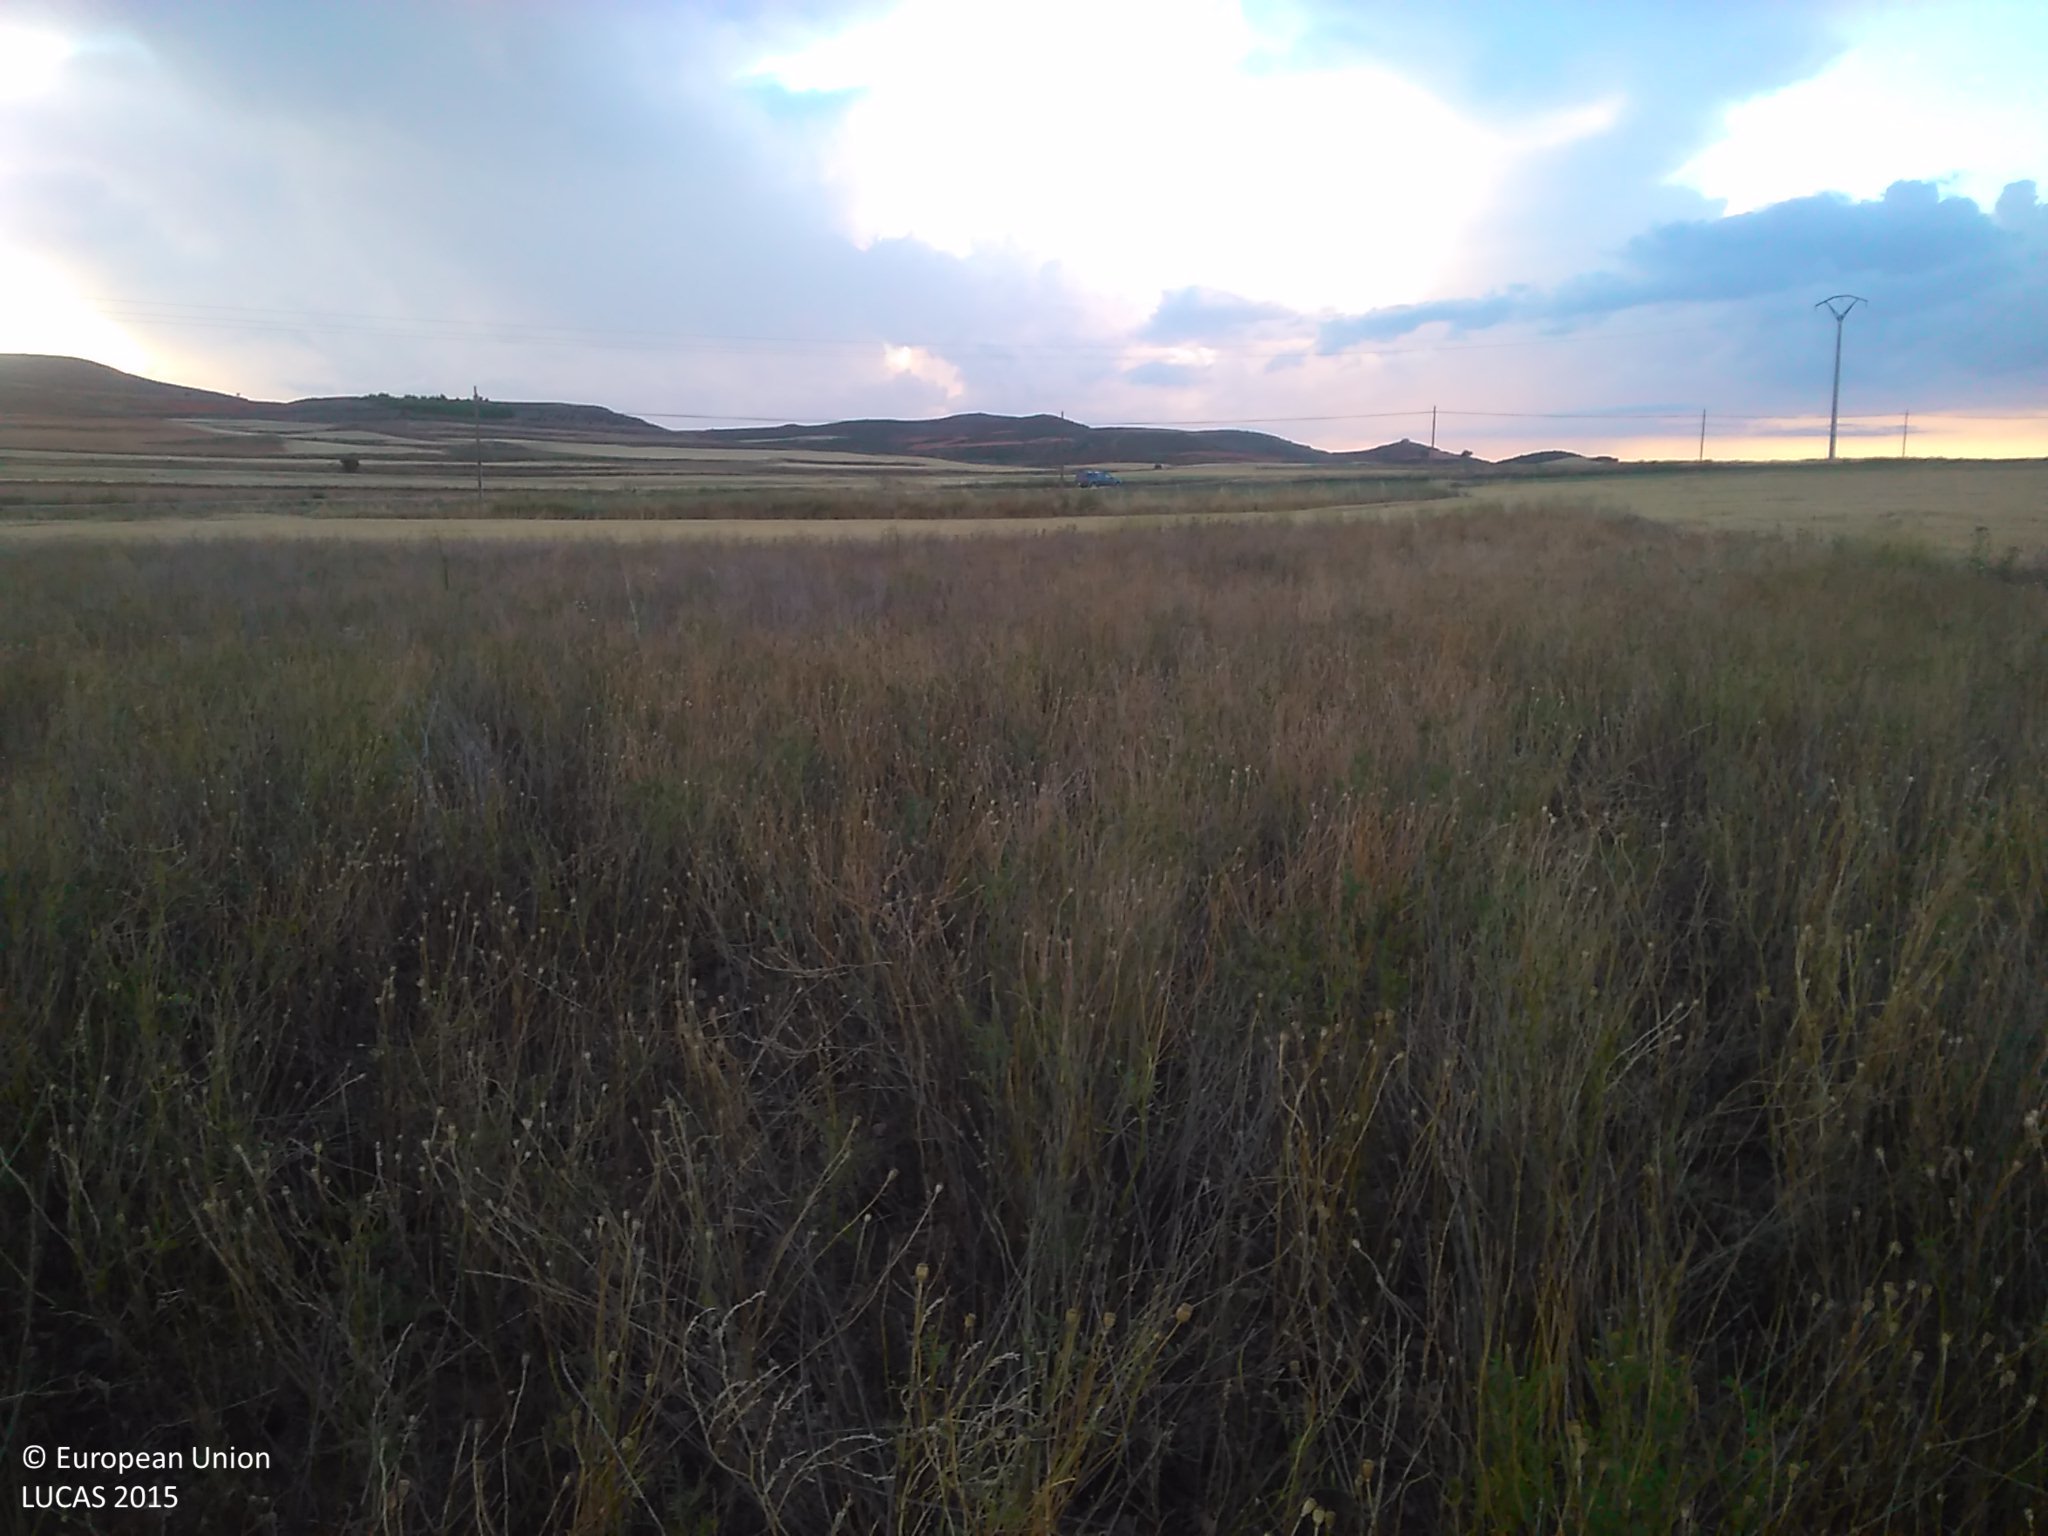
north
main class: Grassland
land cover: Spontaneously vegetated surfaces
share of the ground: > 75 %
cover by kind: herbaceous plants 85 %, unconsolidated bare surface 15 %
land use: Abandoned areas
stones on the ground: < 10 %
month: July
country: ES
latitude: 41.4416
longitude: -2.1797
